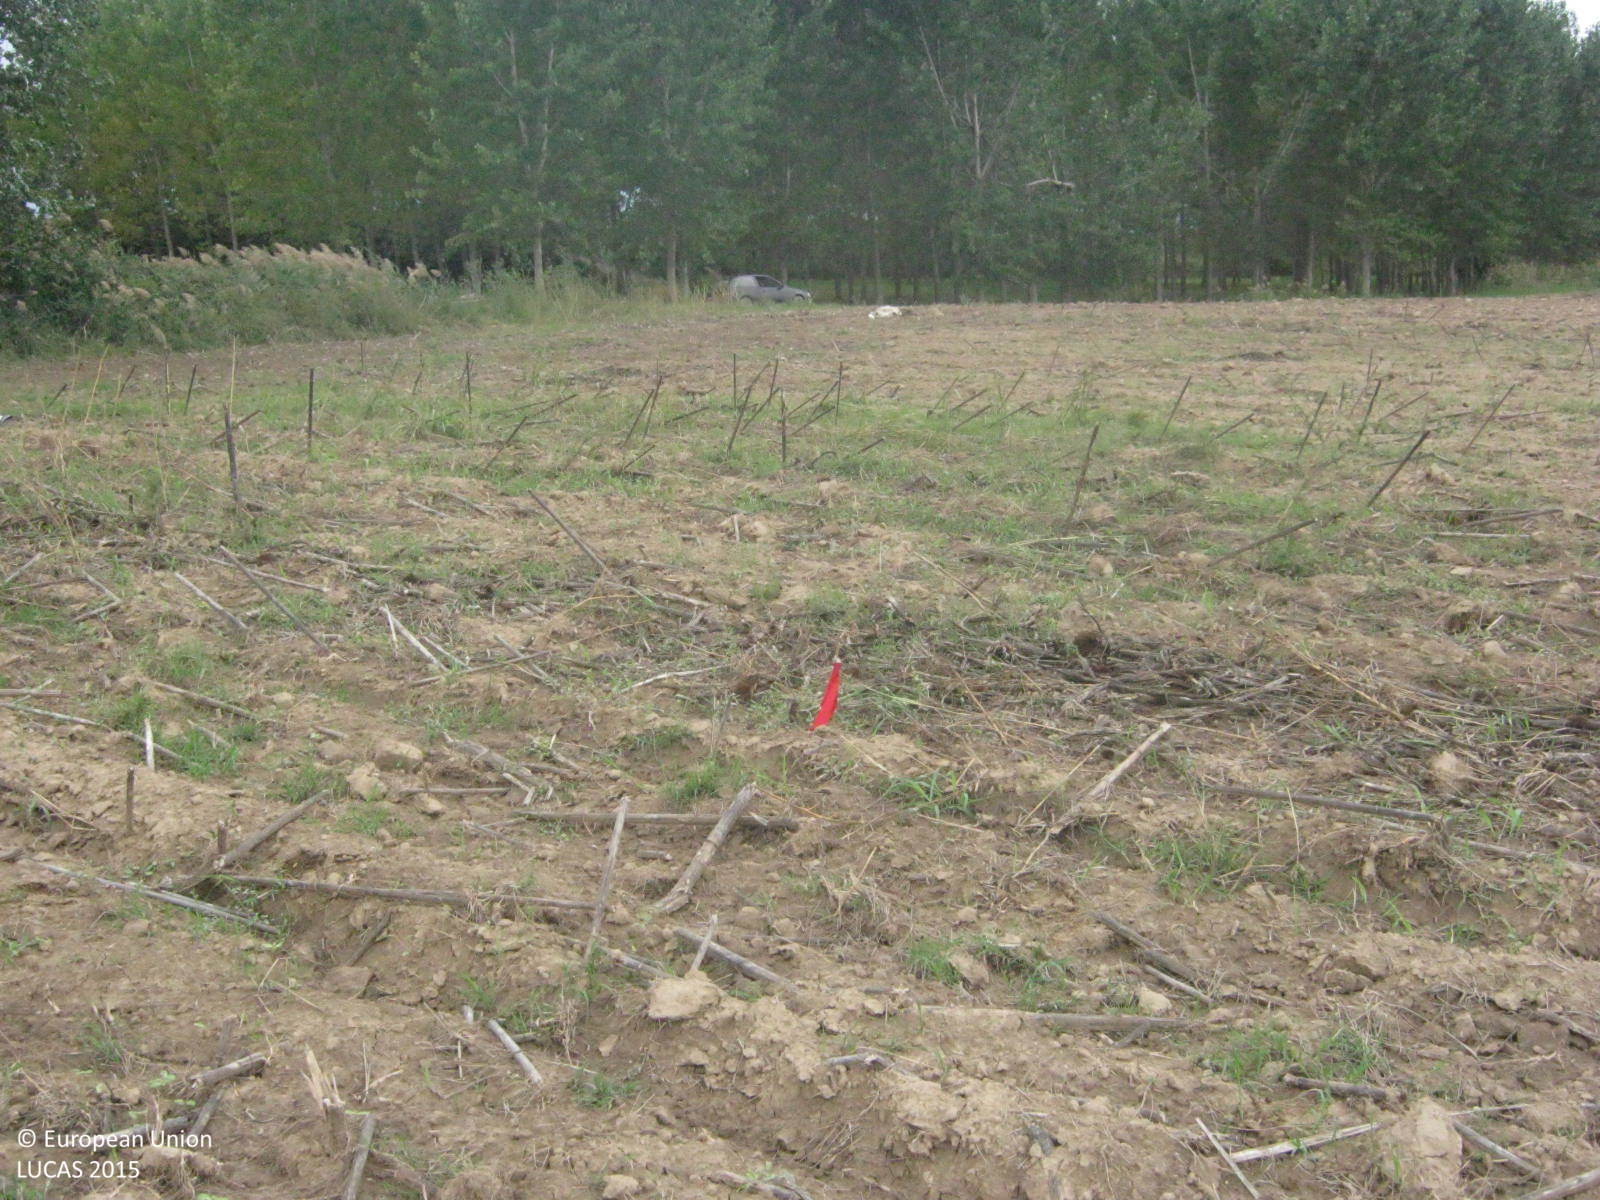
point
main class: Cropland
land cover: Sunflower
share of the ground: > 75 %
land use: Agriculture (excluding fallow land and kitchen gardens)
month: September
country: GR
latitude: 40.8749
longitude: 22.6198
